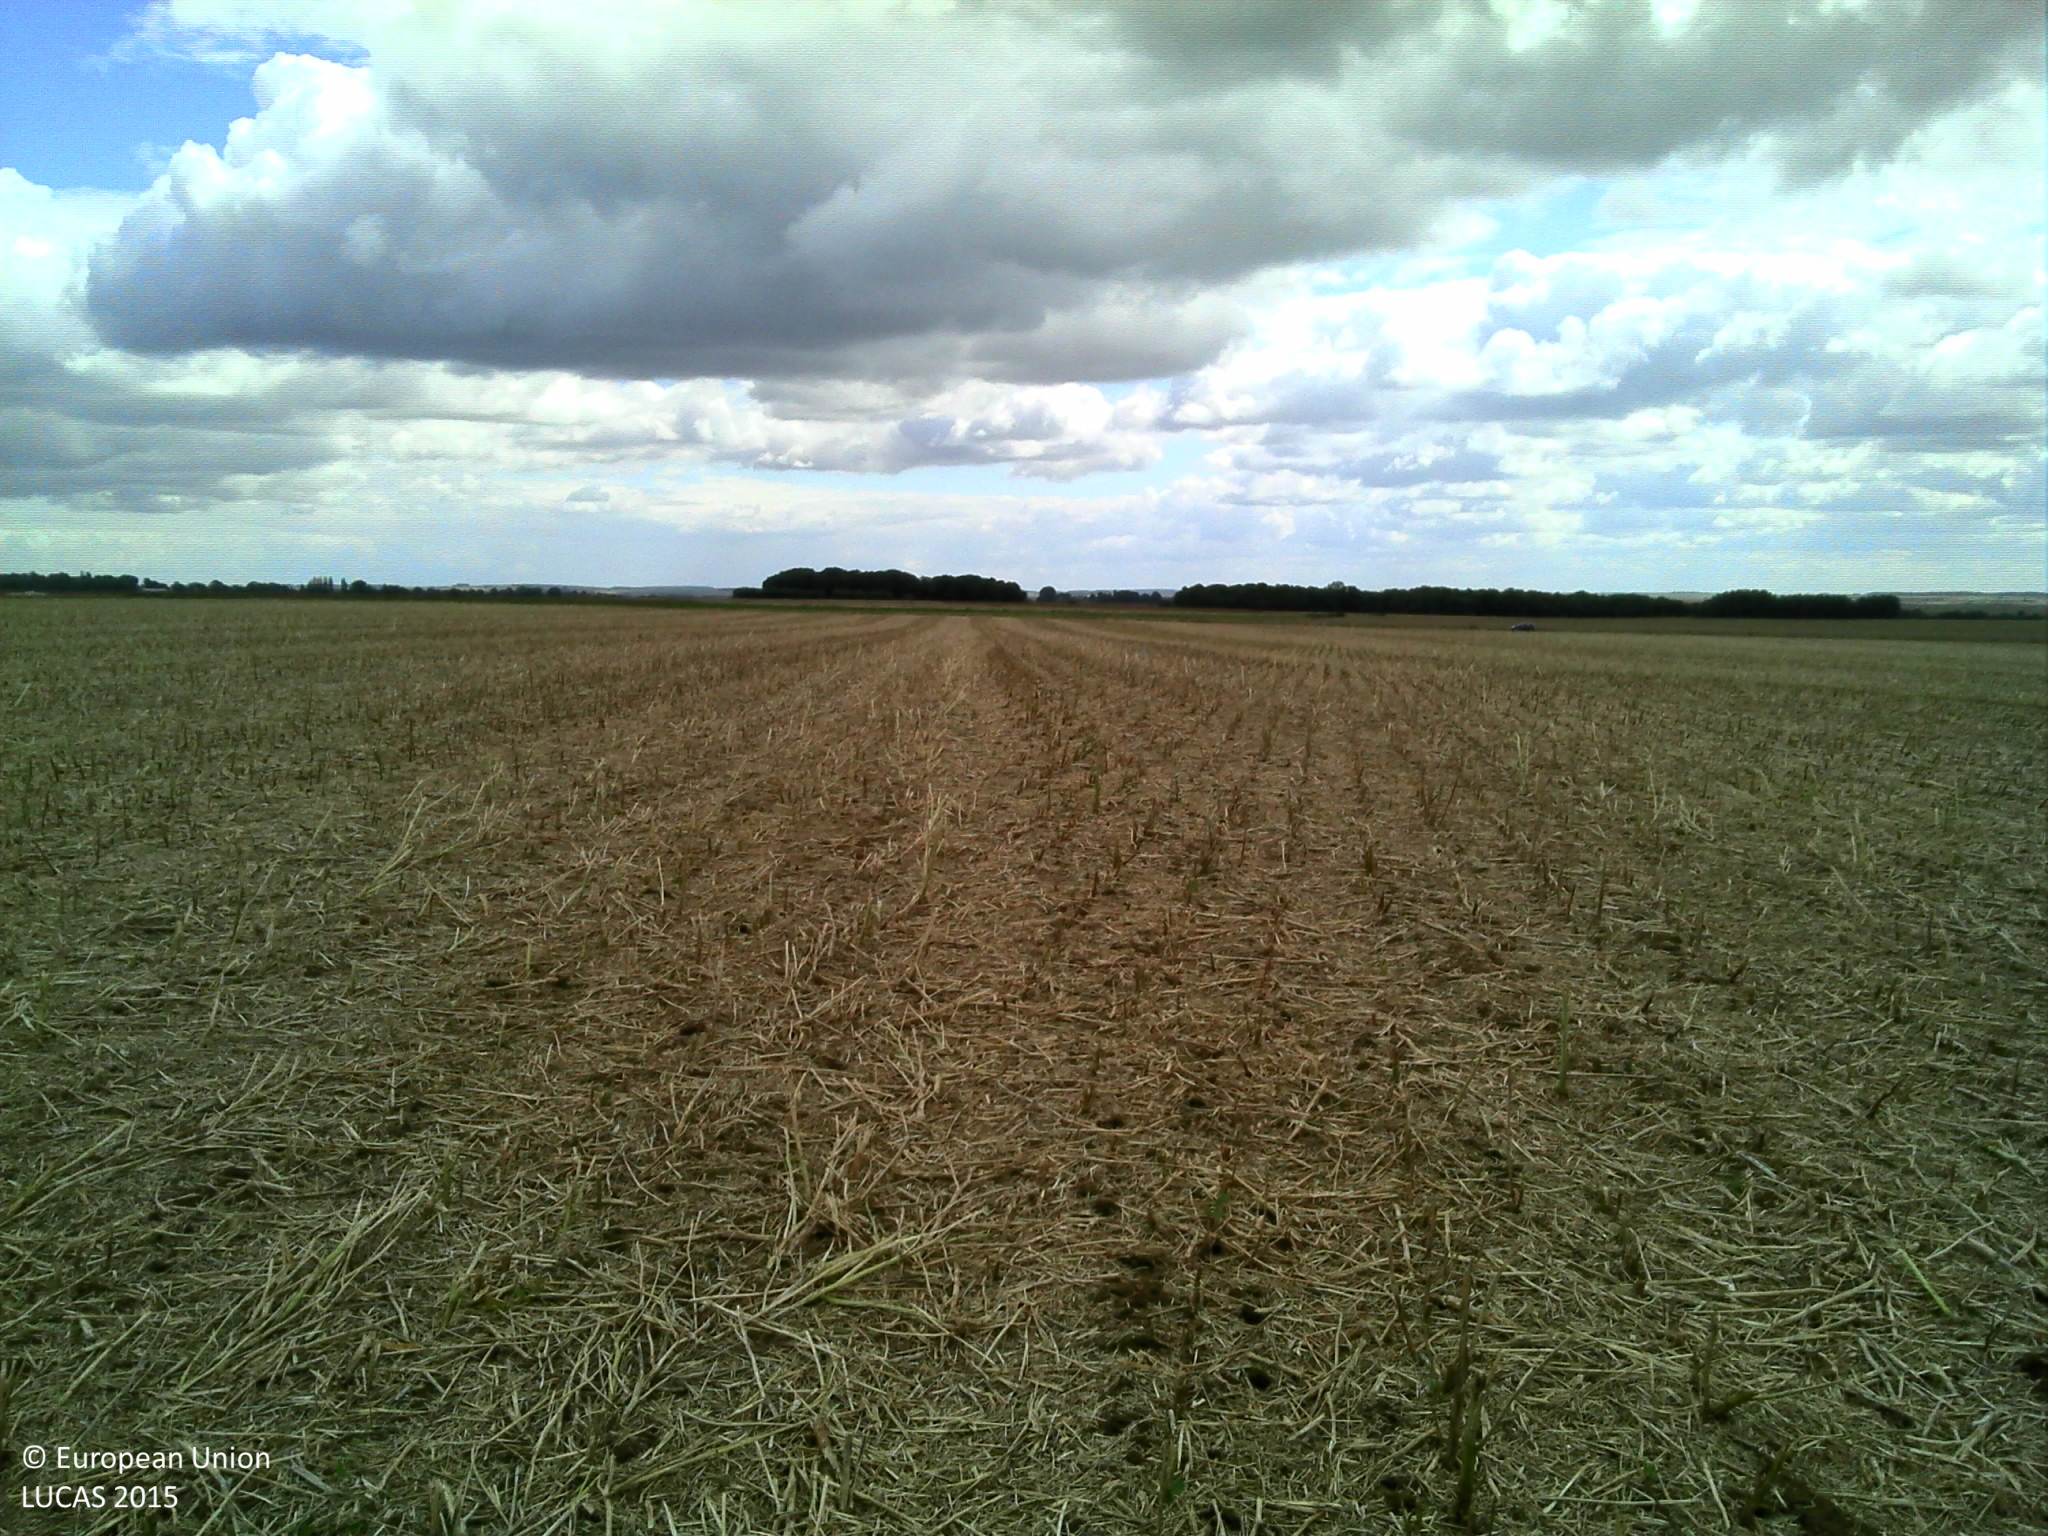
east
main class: Cropland
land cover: Rape and turnip rape
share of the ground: > 75 %
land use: Agriculture (excluding fallow land and kitchen gardens)
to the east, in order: Rape and turnip rape
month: July
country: FR
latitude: 49.9929
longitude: 2.5250
